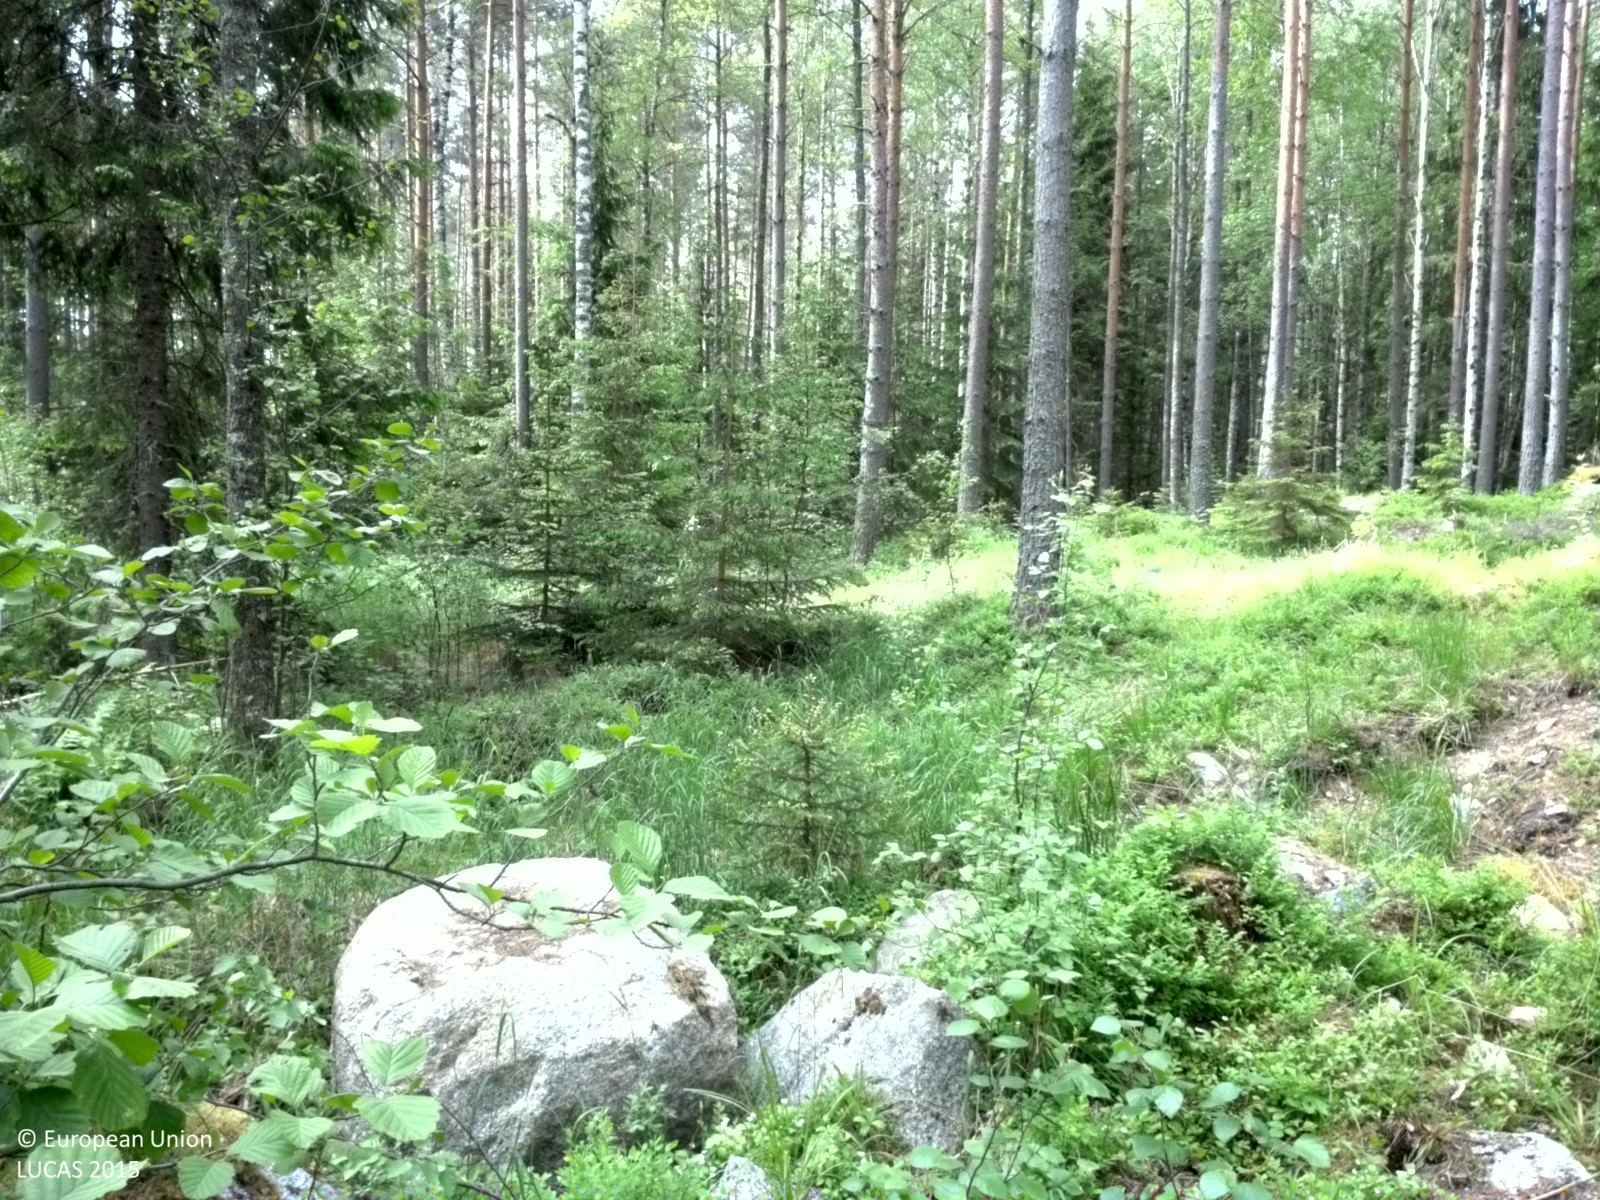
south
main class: Woodland
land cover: Pine dominated coniferous woodland
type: boreal forest
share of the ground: 50 - 75 %
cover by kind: coniferous forest trees 65 %, shrubs 15 %, herbaceous plants 10 %, broadleaved forest trees 5 %, lichens and mosses 5 %
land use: Forestry
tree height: > 5 m
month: June
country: SE
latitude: 60.2839
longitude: 17.2433
